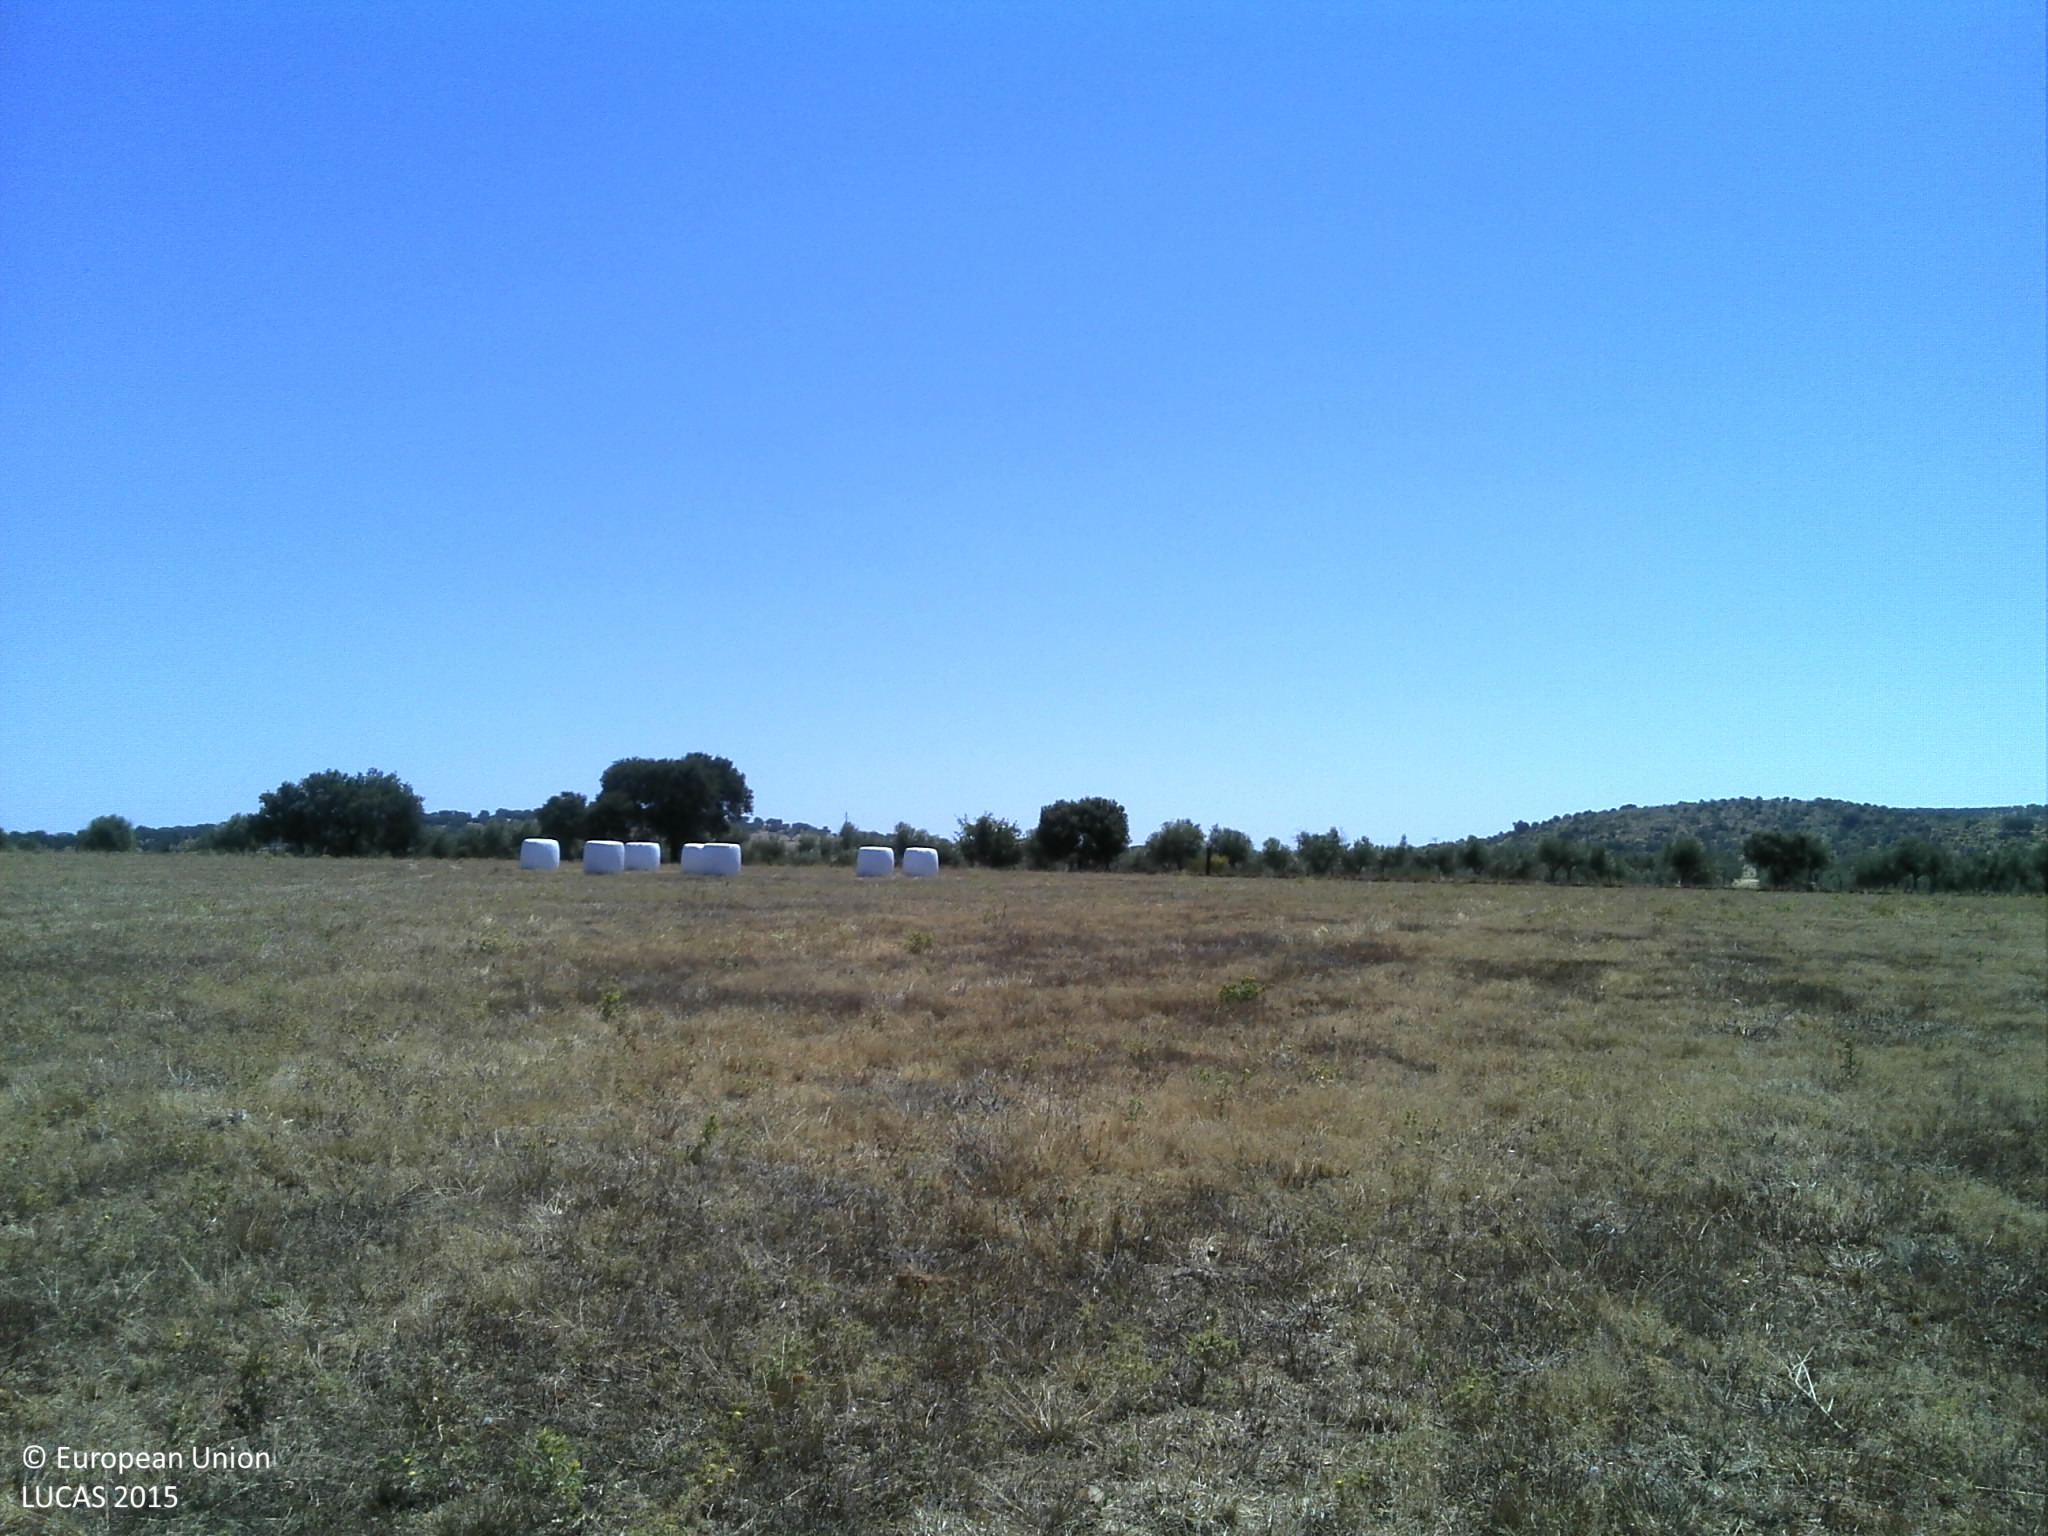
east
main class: Cropland
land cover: Temporary grasslands
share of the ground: 10 - 25 %
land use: Agriculture (excluding fallow land and kitchen gardens)
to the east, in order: Temporary grasslands; Other bare soil; Fences; Olive groves; Tracks; Grass margins; Fences; Olive groves
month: July
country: PT
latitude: 39.1030
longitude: -7.5124
